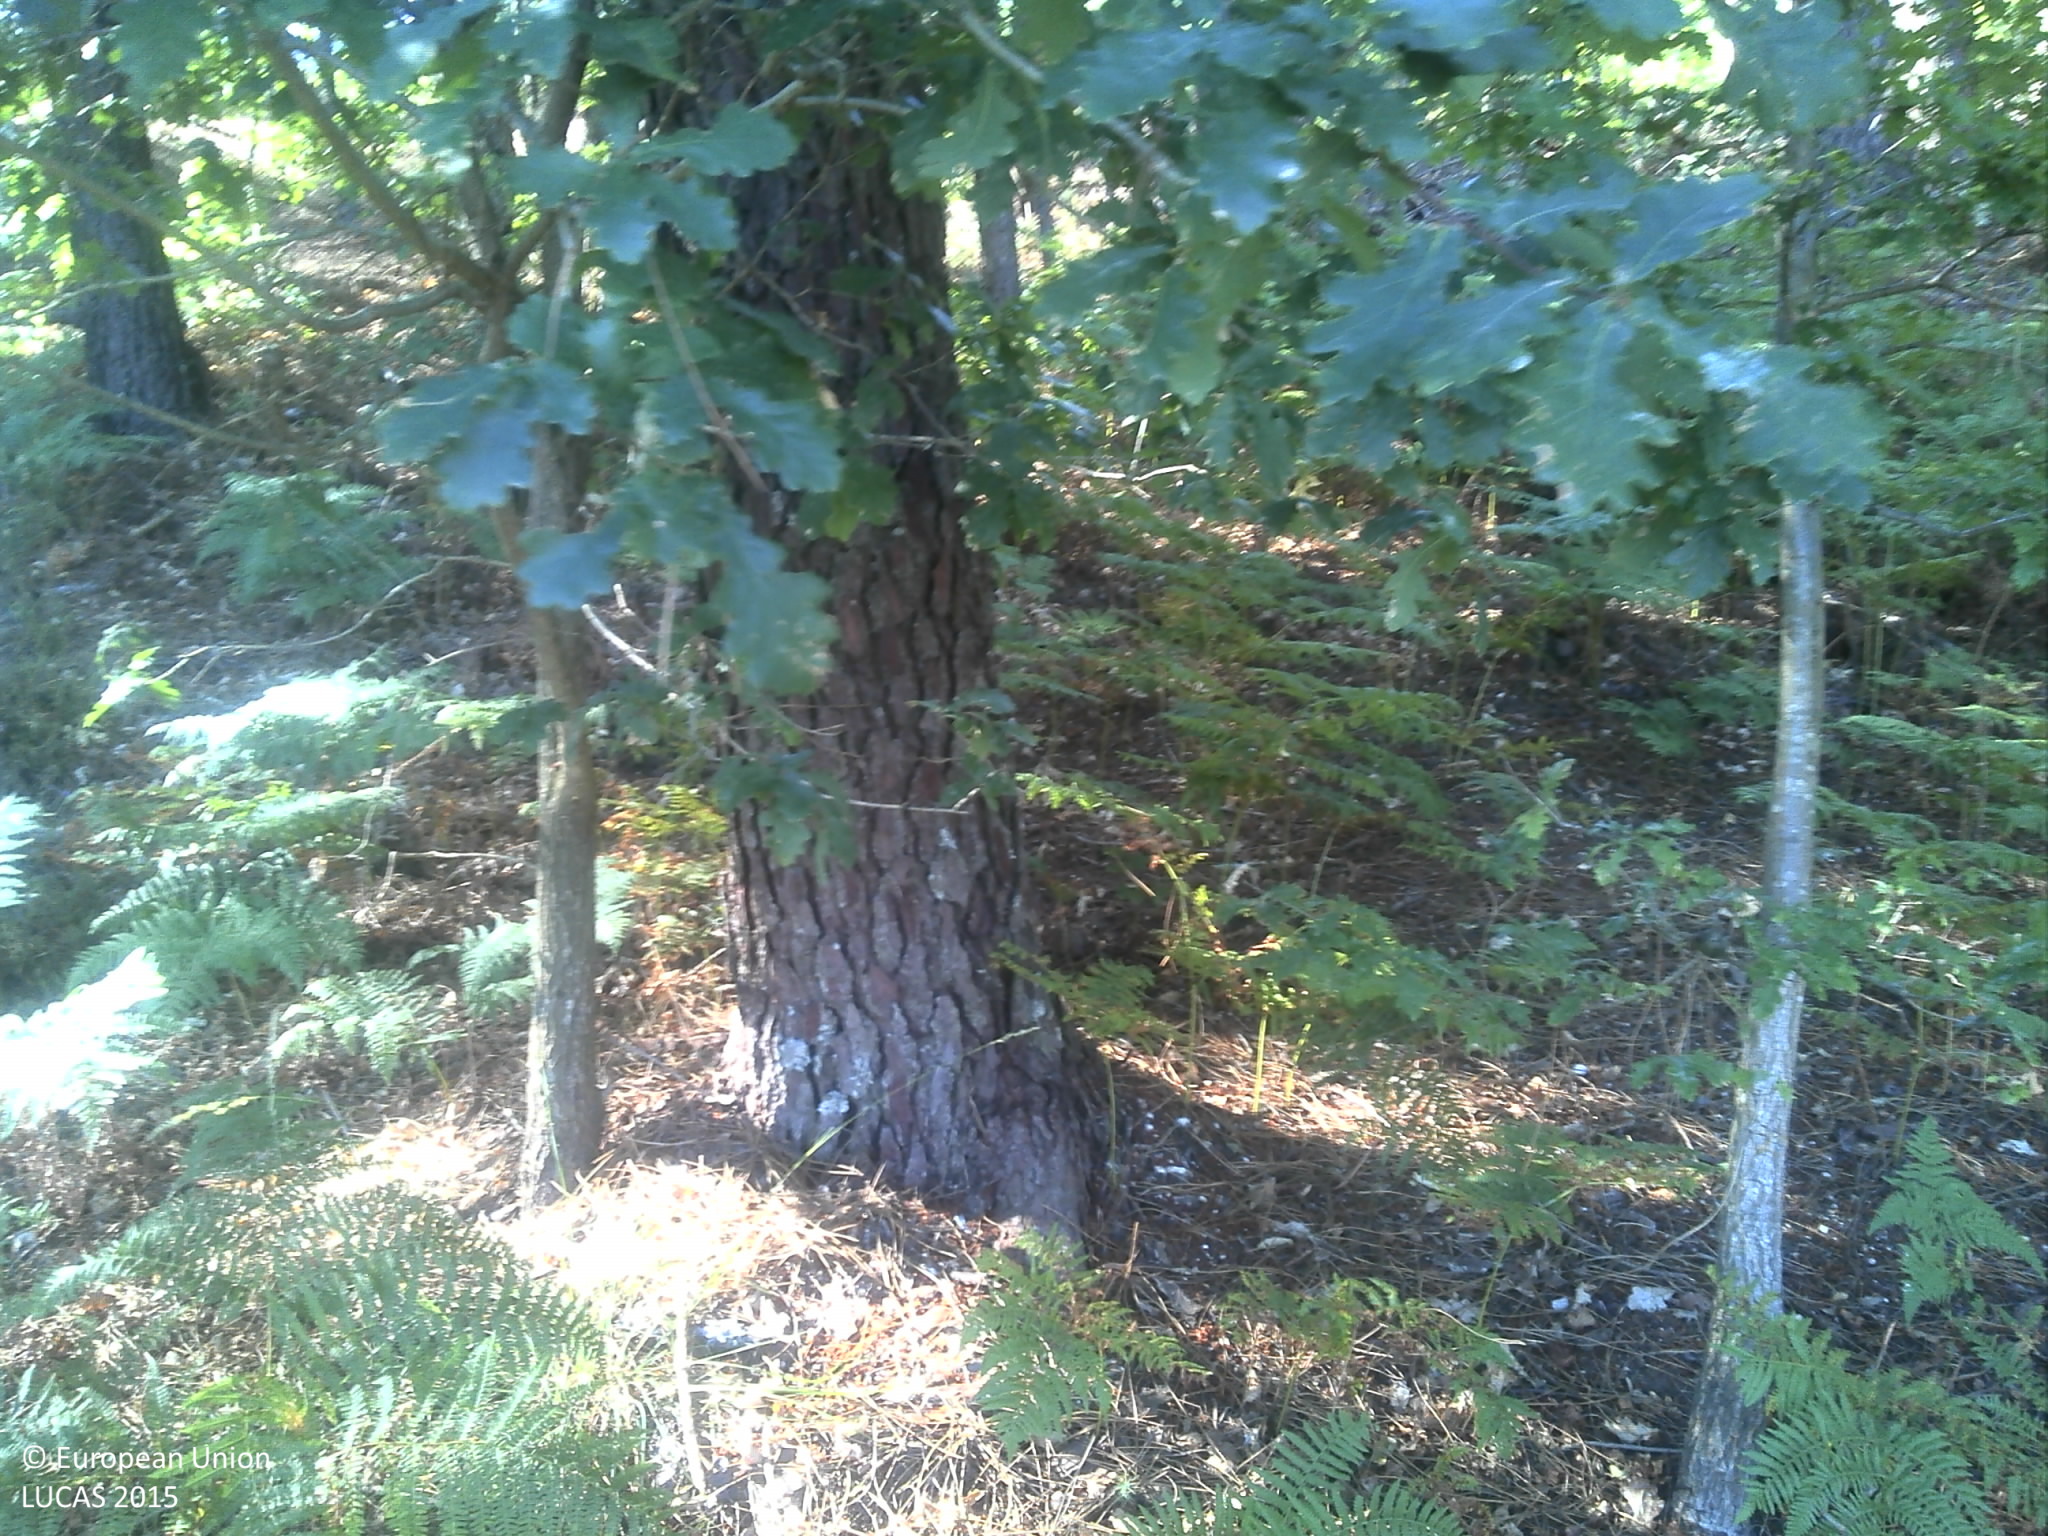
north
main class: Woodland
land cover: Pine dominated coniferous woodland
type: coniferous forest of the mediterranean region
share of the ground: 50 - 75 %
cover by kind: coniferous forest trees 70 %, shrubs 15 %, unconsolidated bare surface 10 %, herbaceous plants 5 %
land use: Forestry
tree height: > 5 m
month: June
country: PT
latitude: 41.3698
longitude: -8.1356
